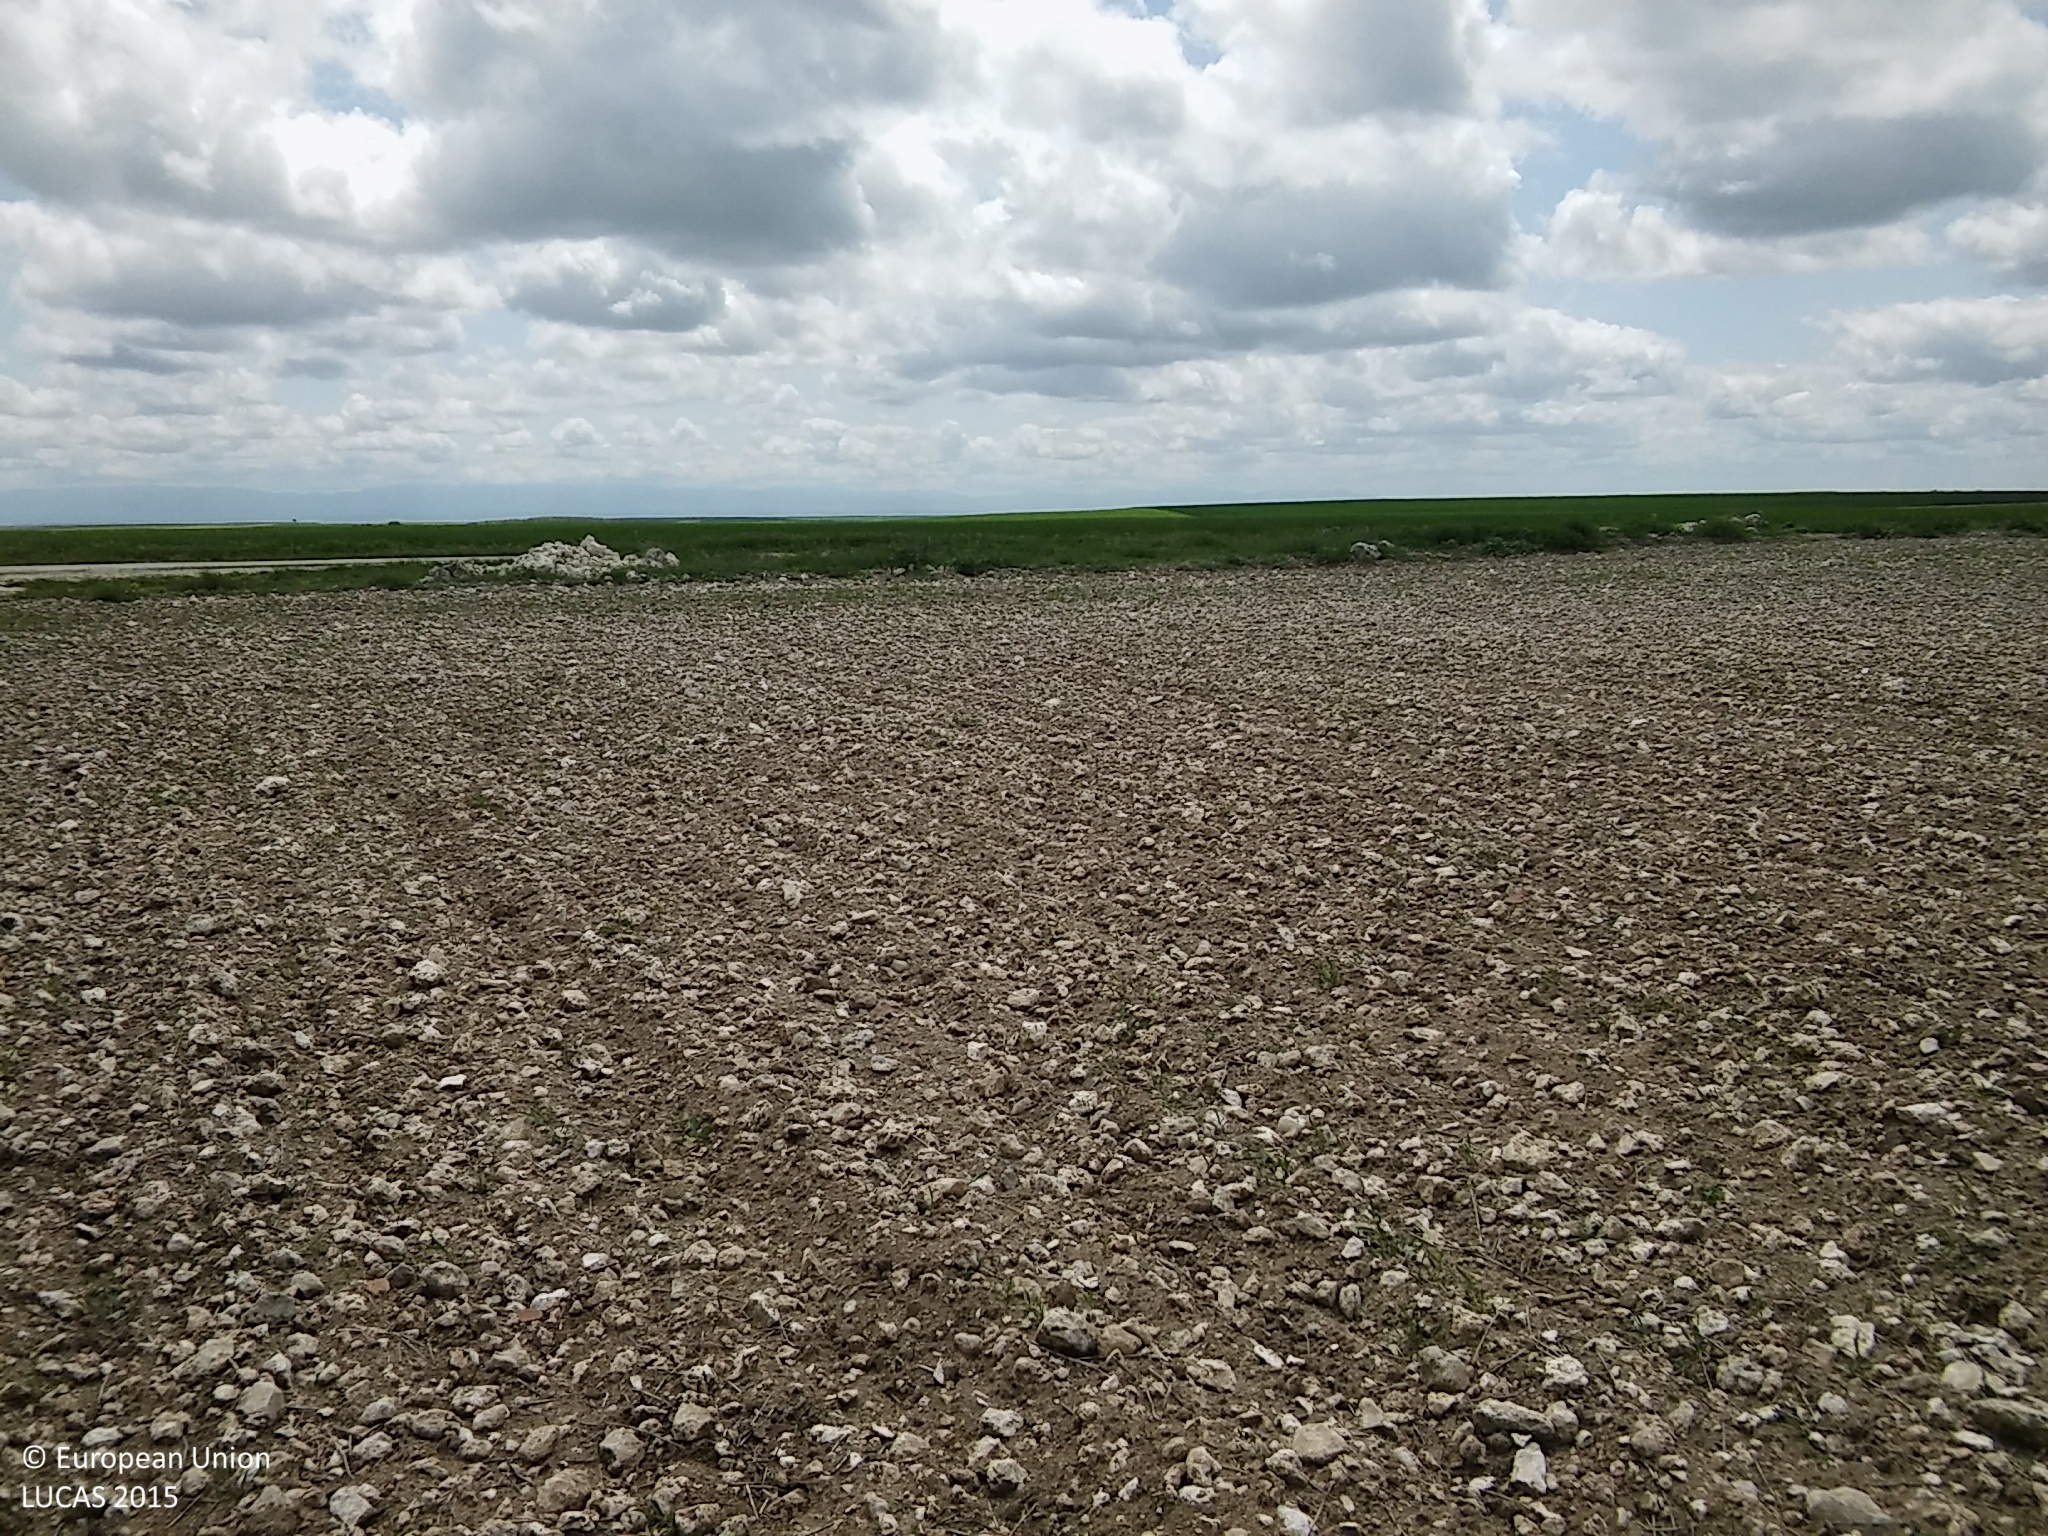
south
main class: Cropland
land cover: Sunflower
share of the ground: < 10 %
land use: Agriculture (excluding fallow land and kitchen gardens)
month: May
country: ES
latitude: 41.4320
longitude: -4.0446
